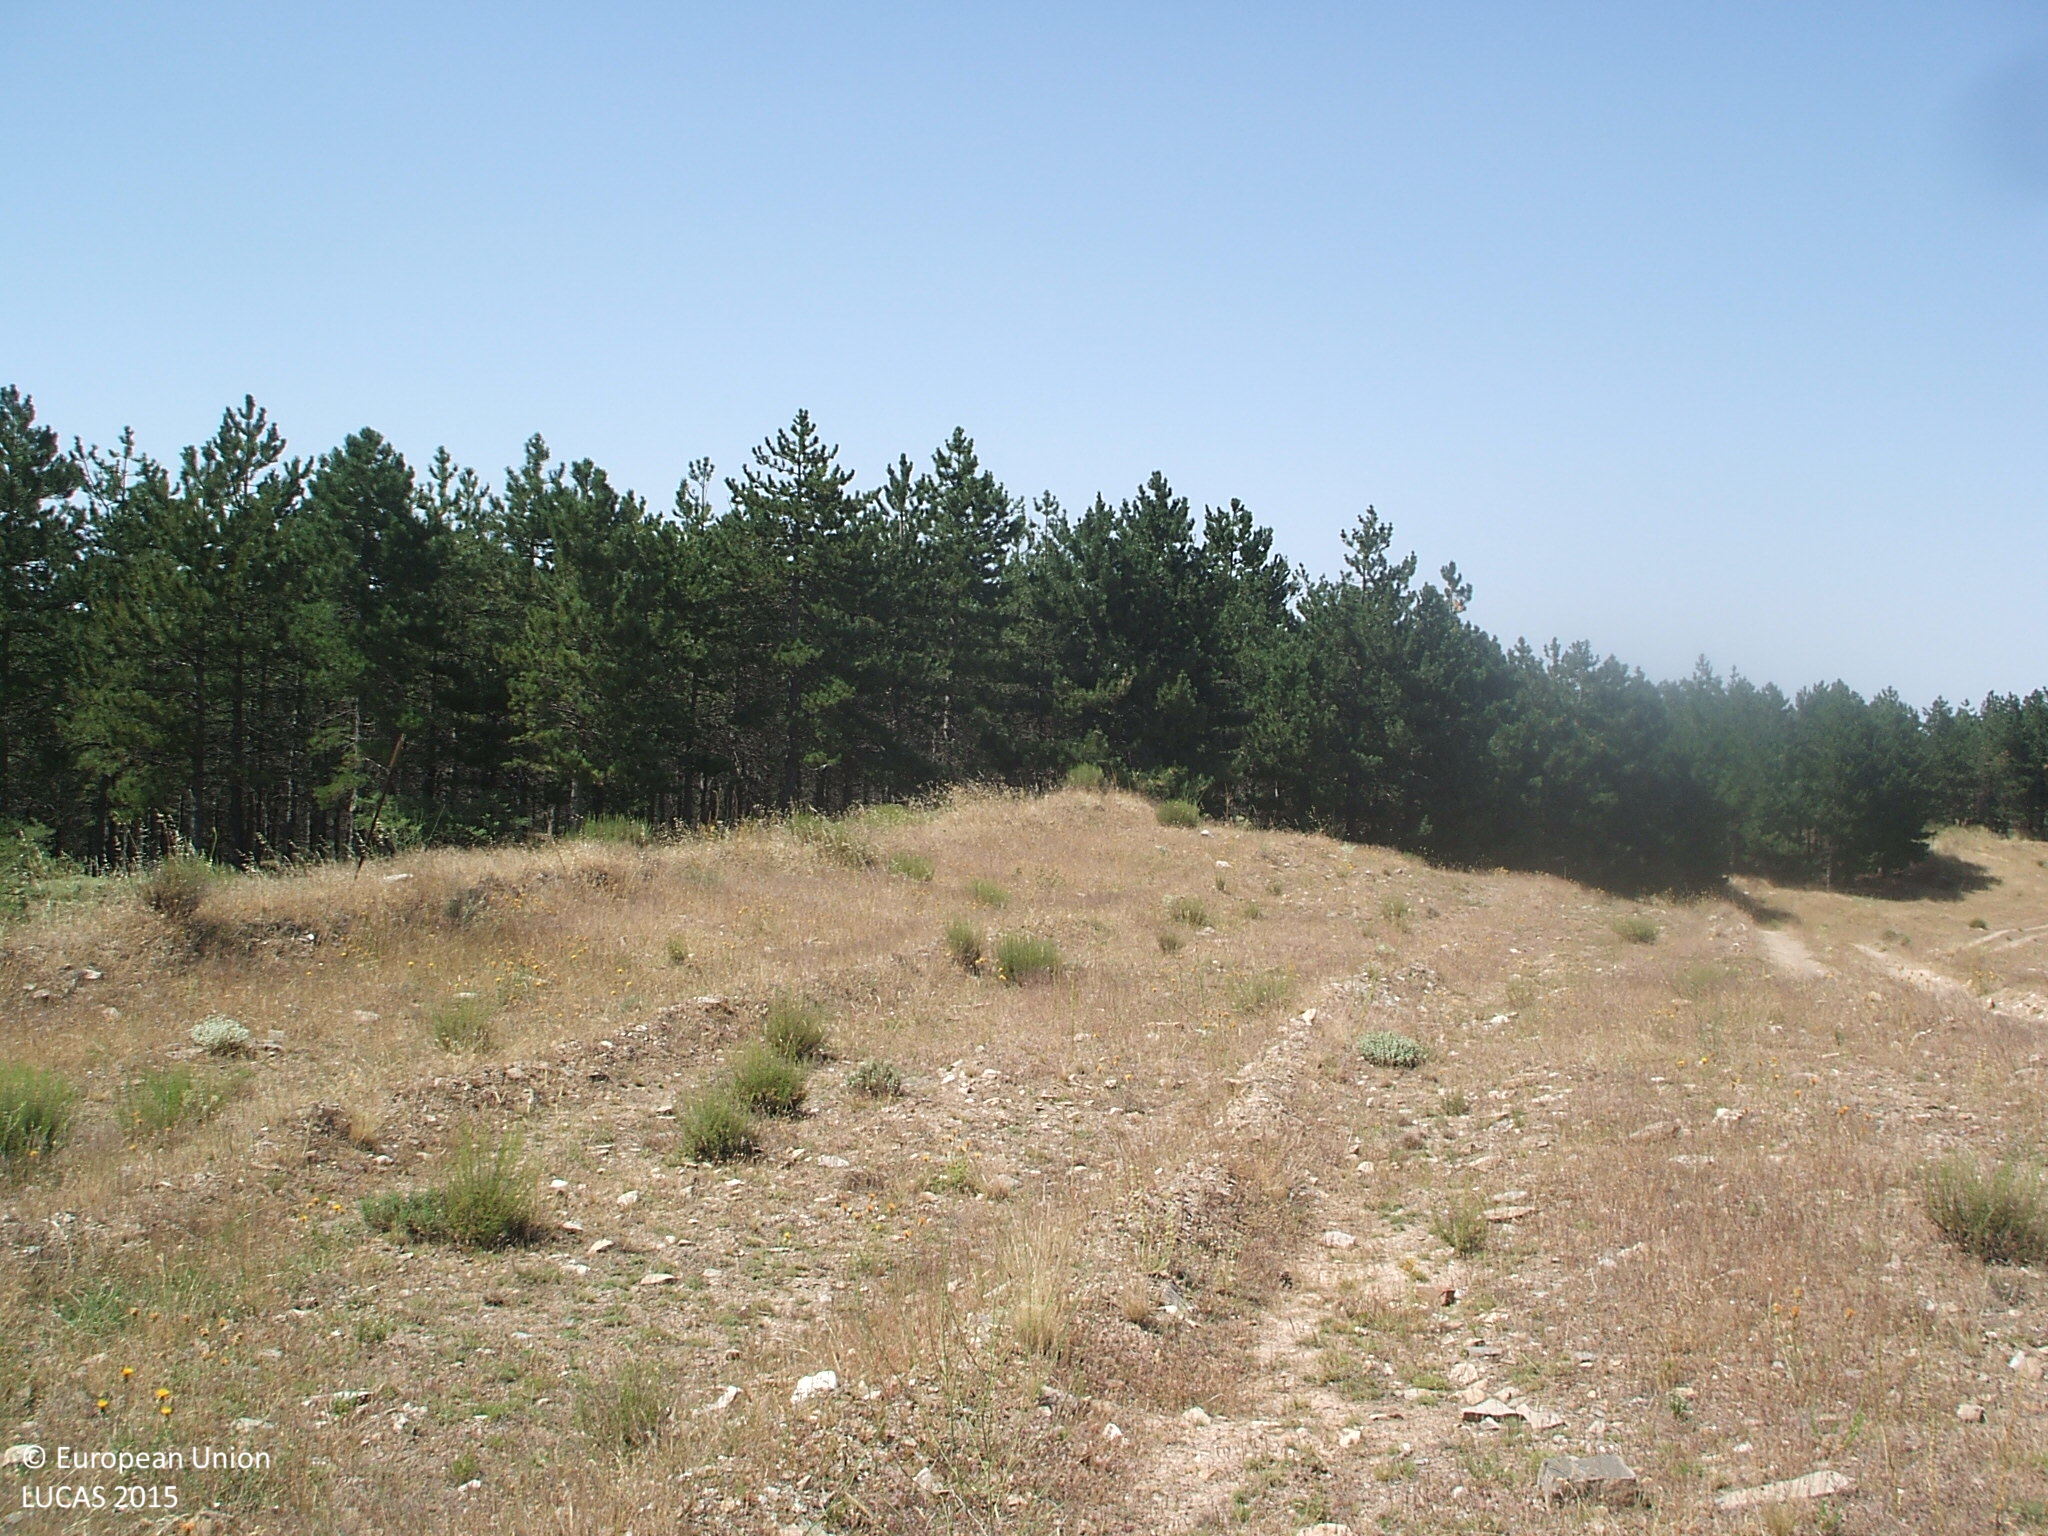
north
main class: Grassland
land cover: Grassland without tree/shrub cover
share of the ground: > 75 %
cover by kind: herbaceous plants 75 %, unconsolidated bare surface 15 %, shrubs 5 %, consolidated bare surface 5 %
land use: Forestry
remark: Fire break
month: July
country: ES
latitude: 37.2480
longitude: -2.3705
